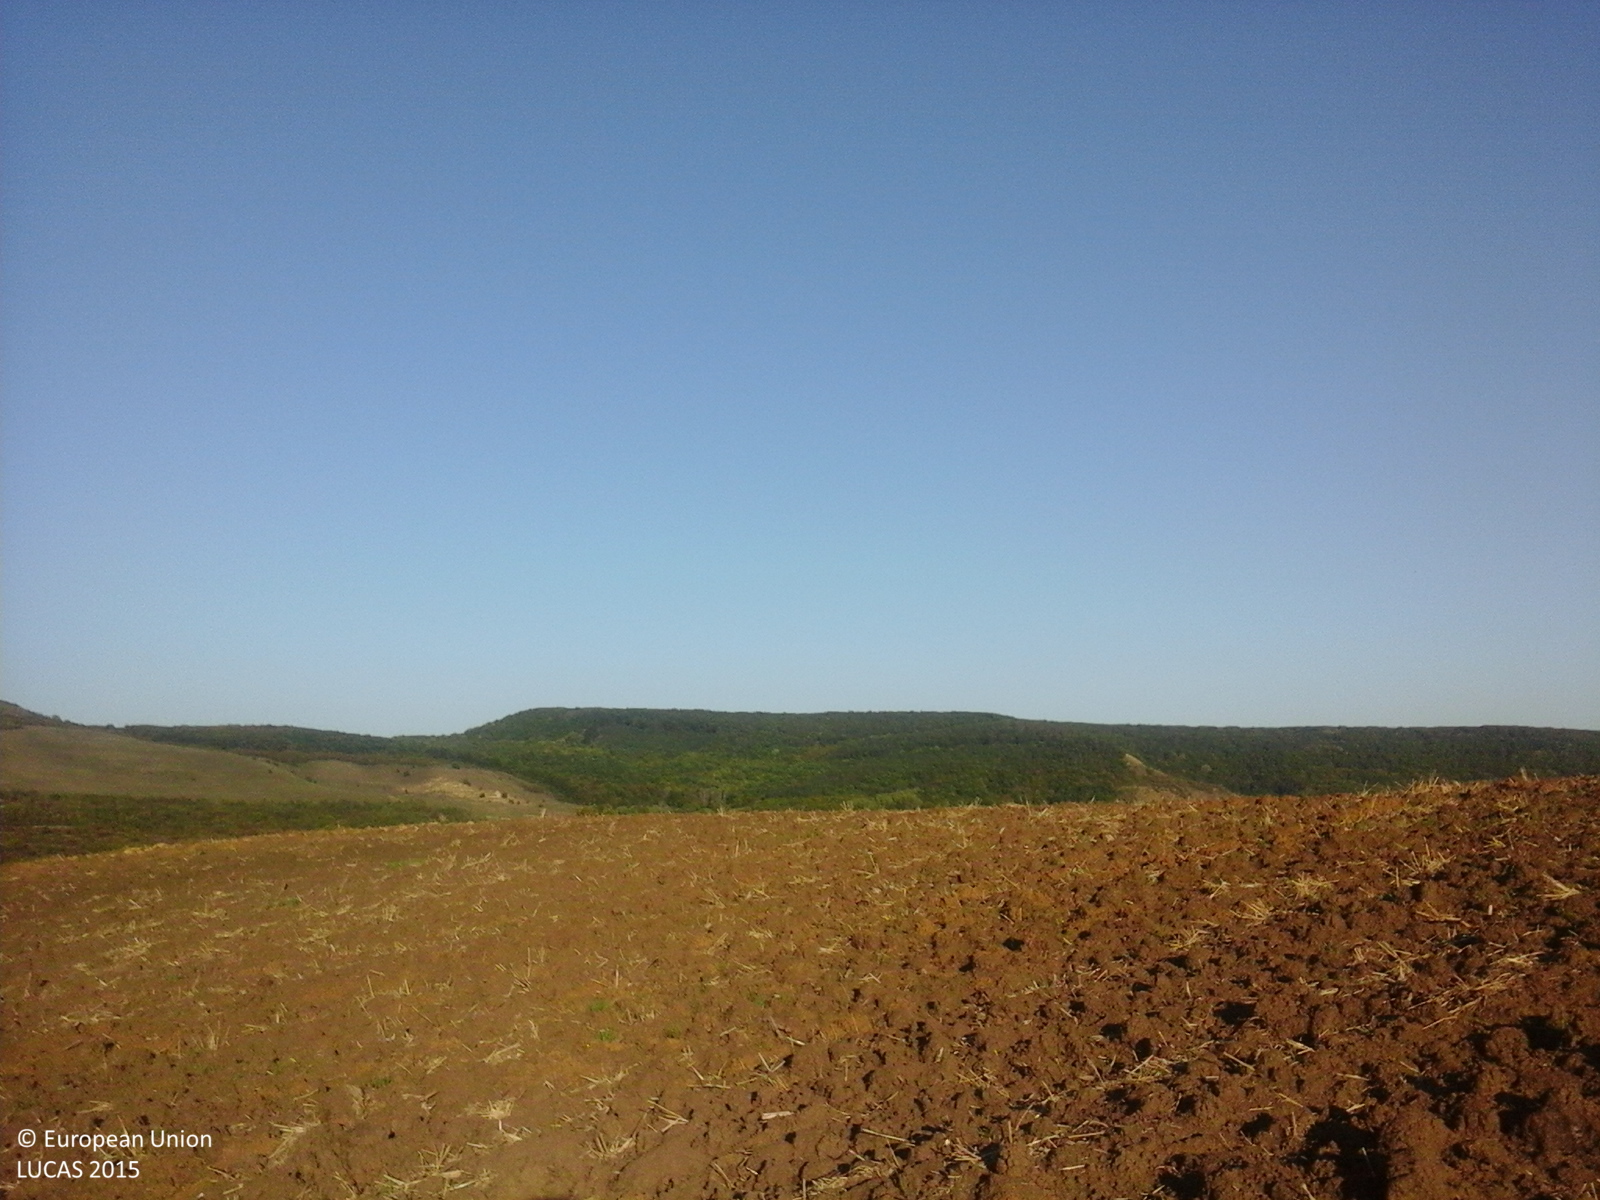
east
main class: Cropland
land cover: Common wheat
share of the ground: < 10 %
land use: Agriculture (excluding fallow land and kitchen gardens)
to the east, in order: Common wheat; Abandoned hedges; Grassland with sparse tree/shrub cover
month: October
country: RO
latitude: 46.1775
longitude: 23.9737
